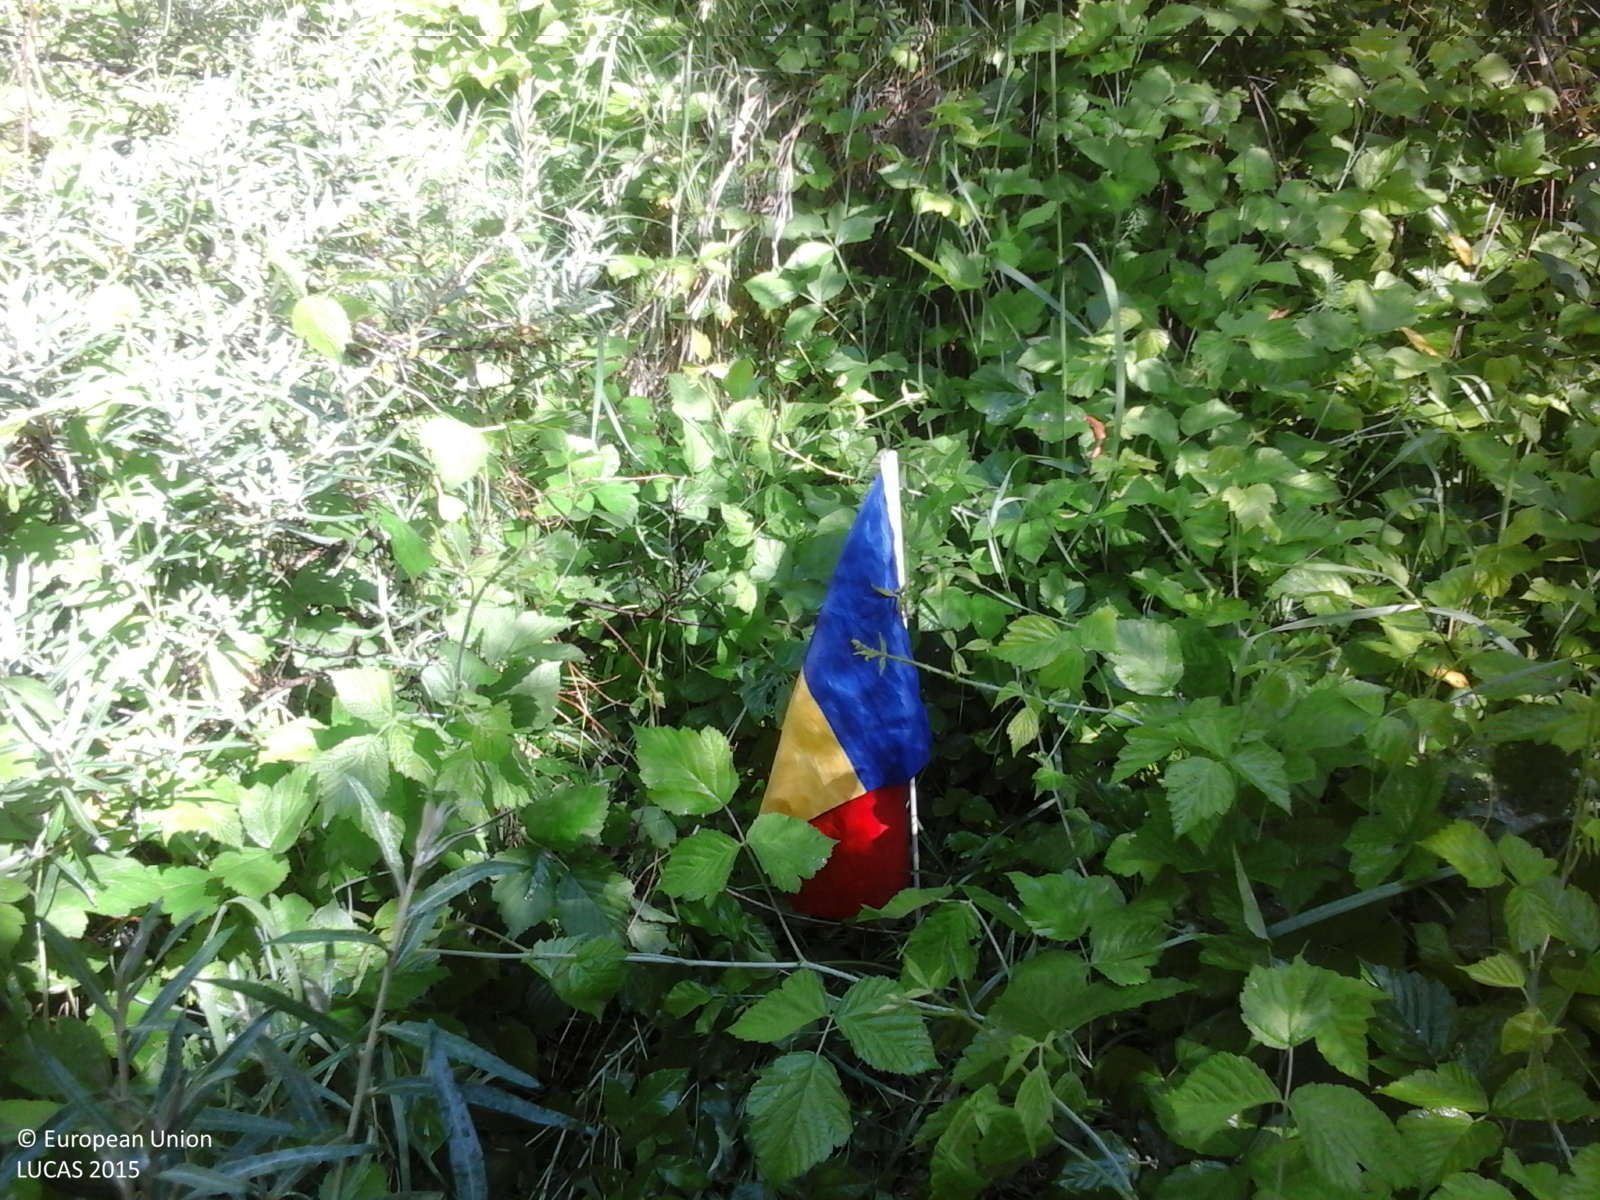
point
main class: Woodland
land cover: Broadleaved woodland
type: non-riverine alder, birch or aspen forest
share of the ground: > 75 %
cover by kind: broadleaved forest trees 100 %
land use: Forestry
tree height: > 5 m
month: June
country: RO
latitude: 46.5006
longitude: 26.6745
